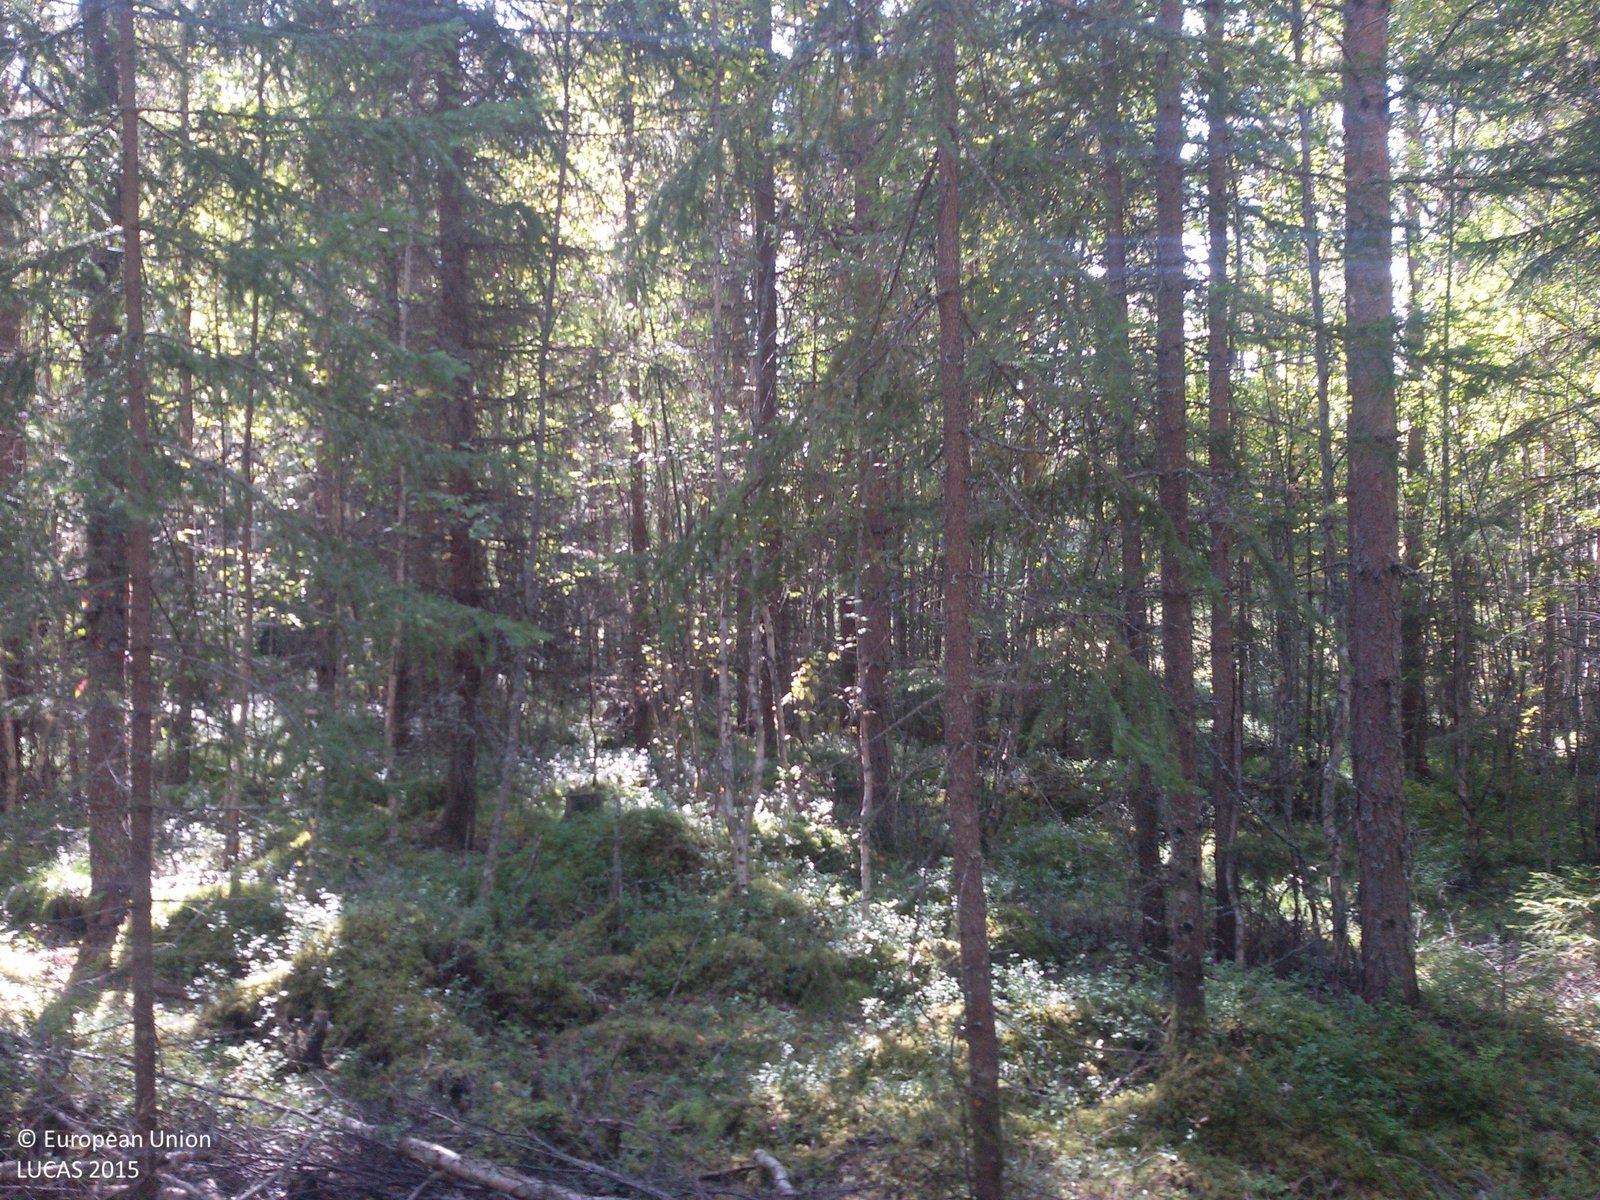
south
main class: Woodland
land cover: Spruce dominated mixed woodland
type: boreal forest
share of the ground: > 75 %
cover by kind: coniferous forest trees 50 %, broadleaved forest trees 30 %, lichens and mosses 10 %
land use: Forestry
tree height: > 5 m
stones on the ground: > 50 %
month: September
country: SE
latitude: 60.9598
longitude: 14.9541
